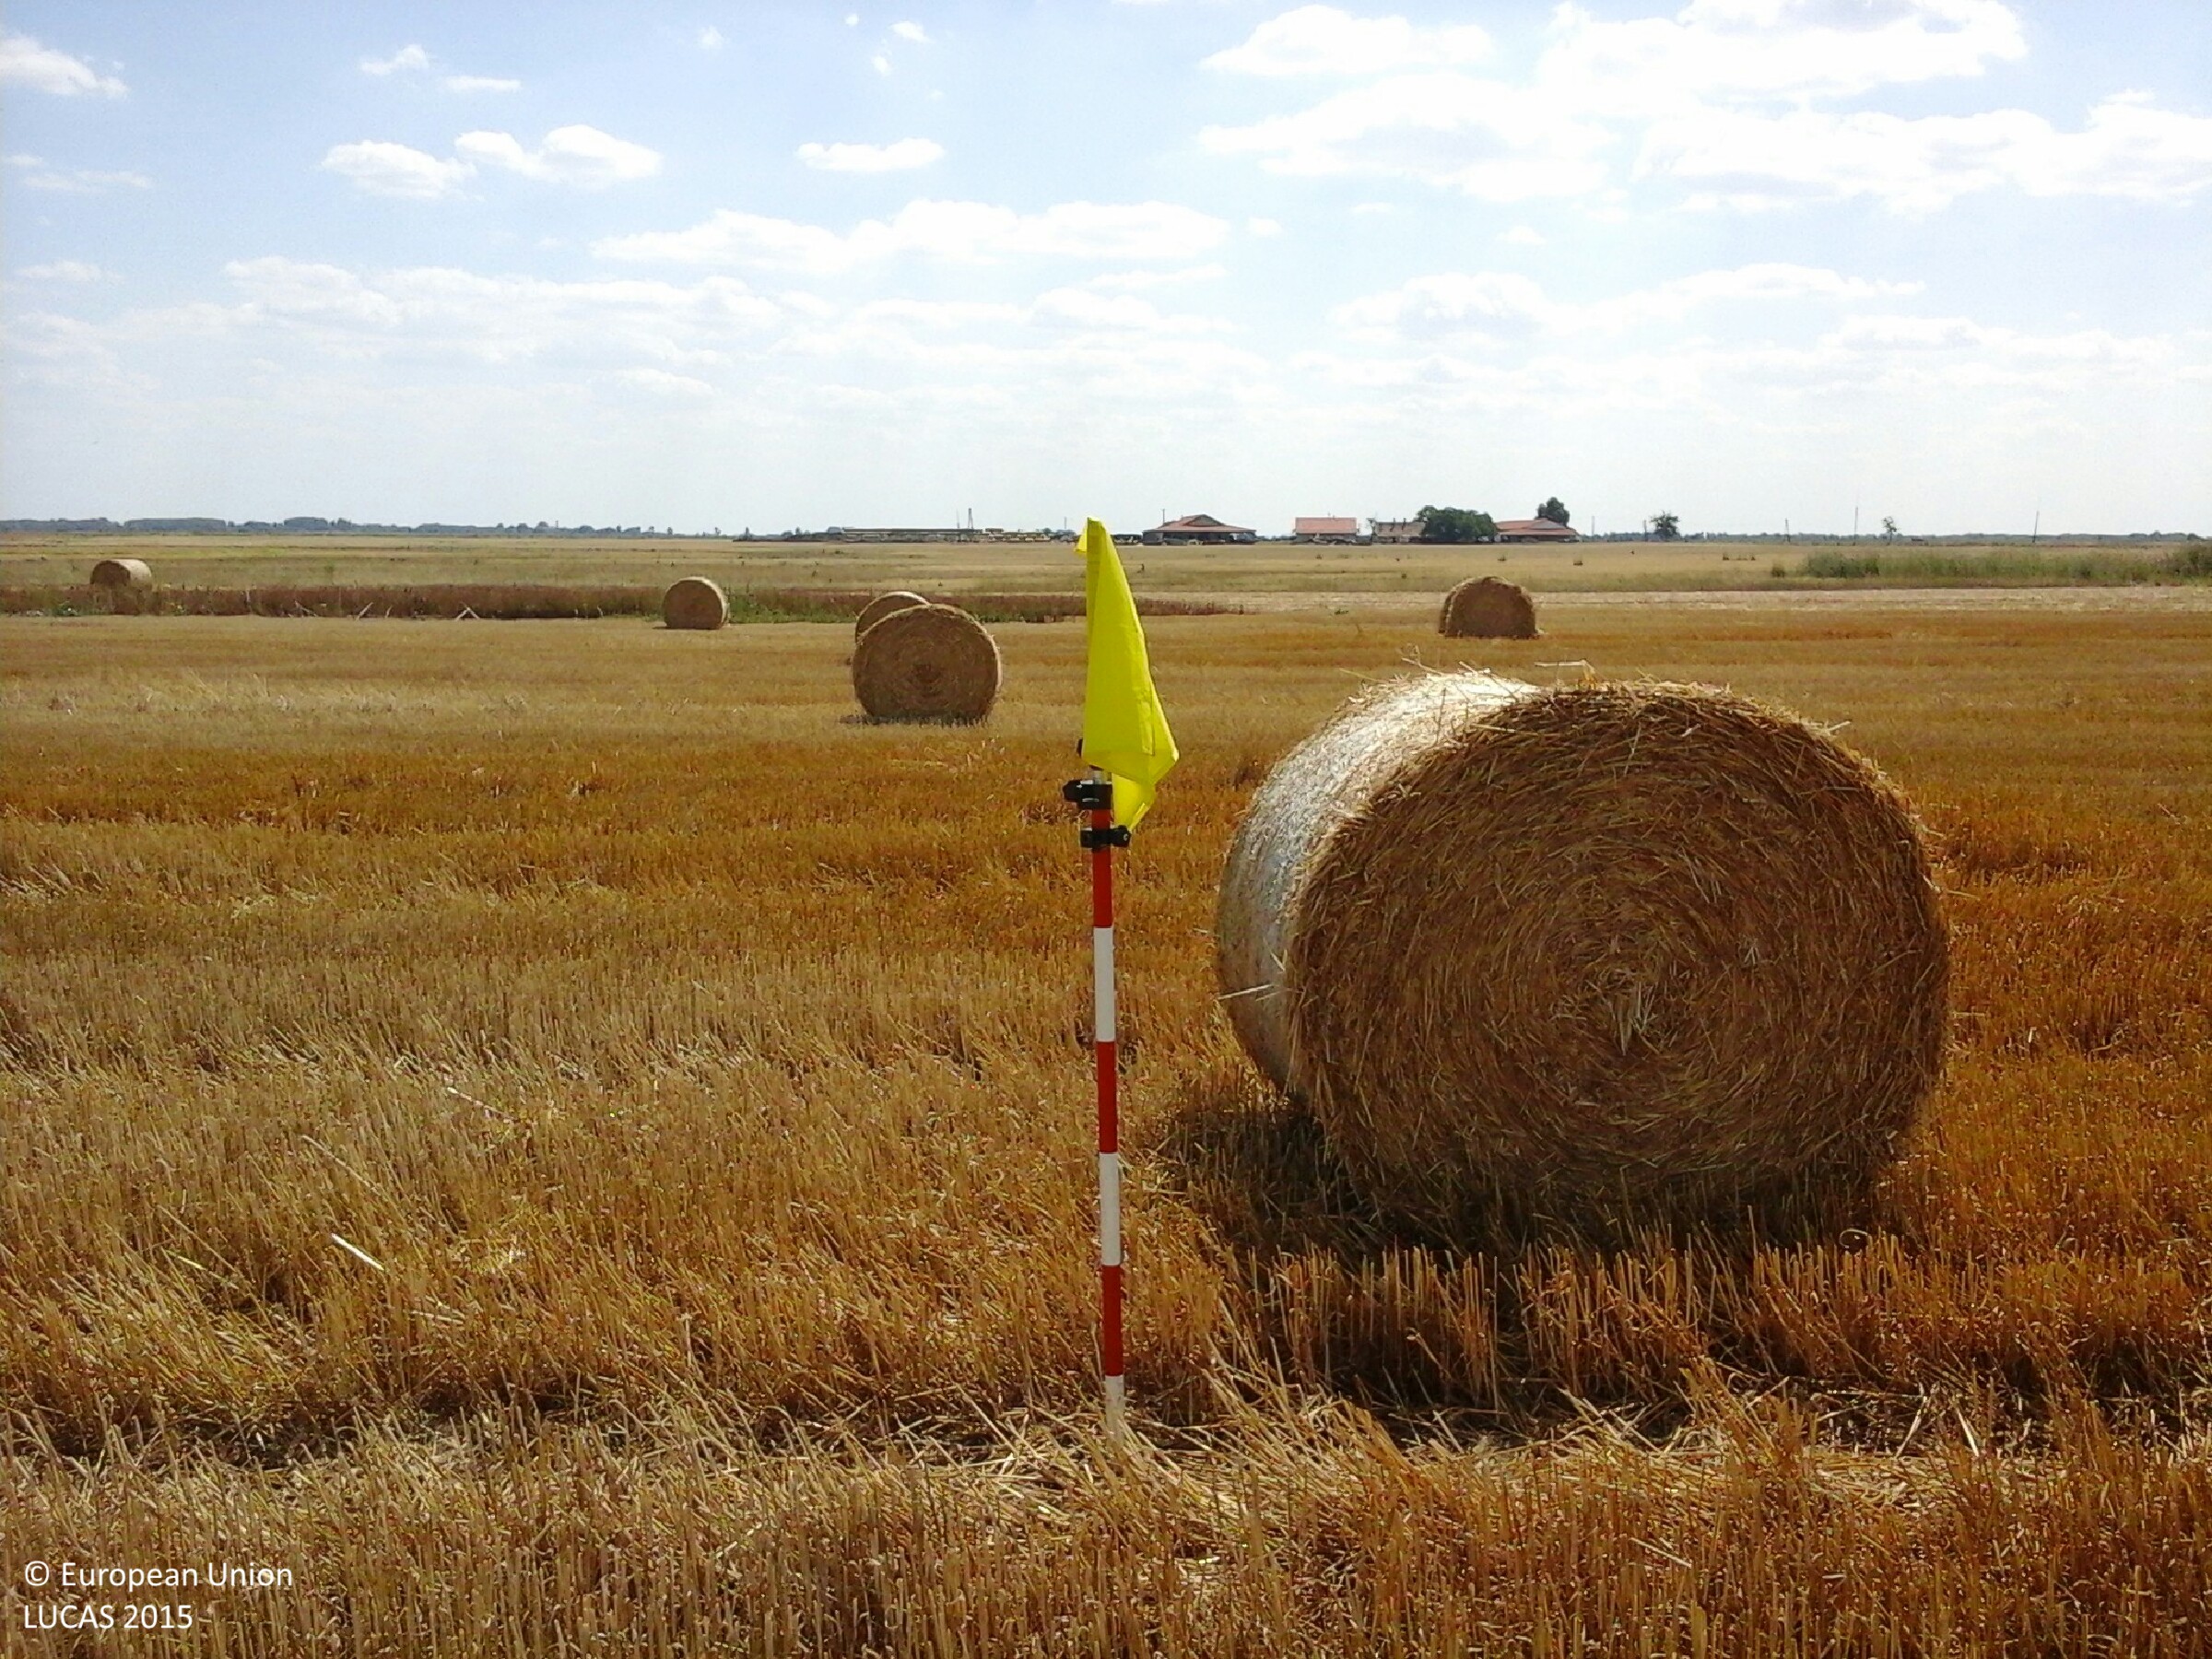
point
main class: Cropland
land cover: Common wheat
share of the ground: 50 - 75 %
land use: Agriculture (excluding fallow land and kitchen gardens)
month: July
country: HU
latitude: 47.6574
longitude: 20.5914
